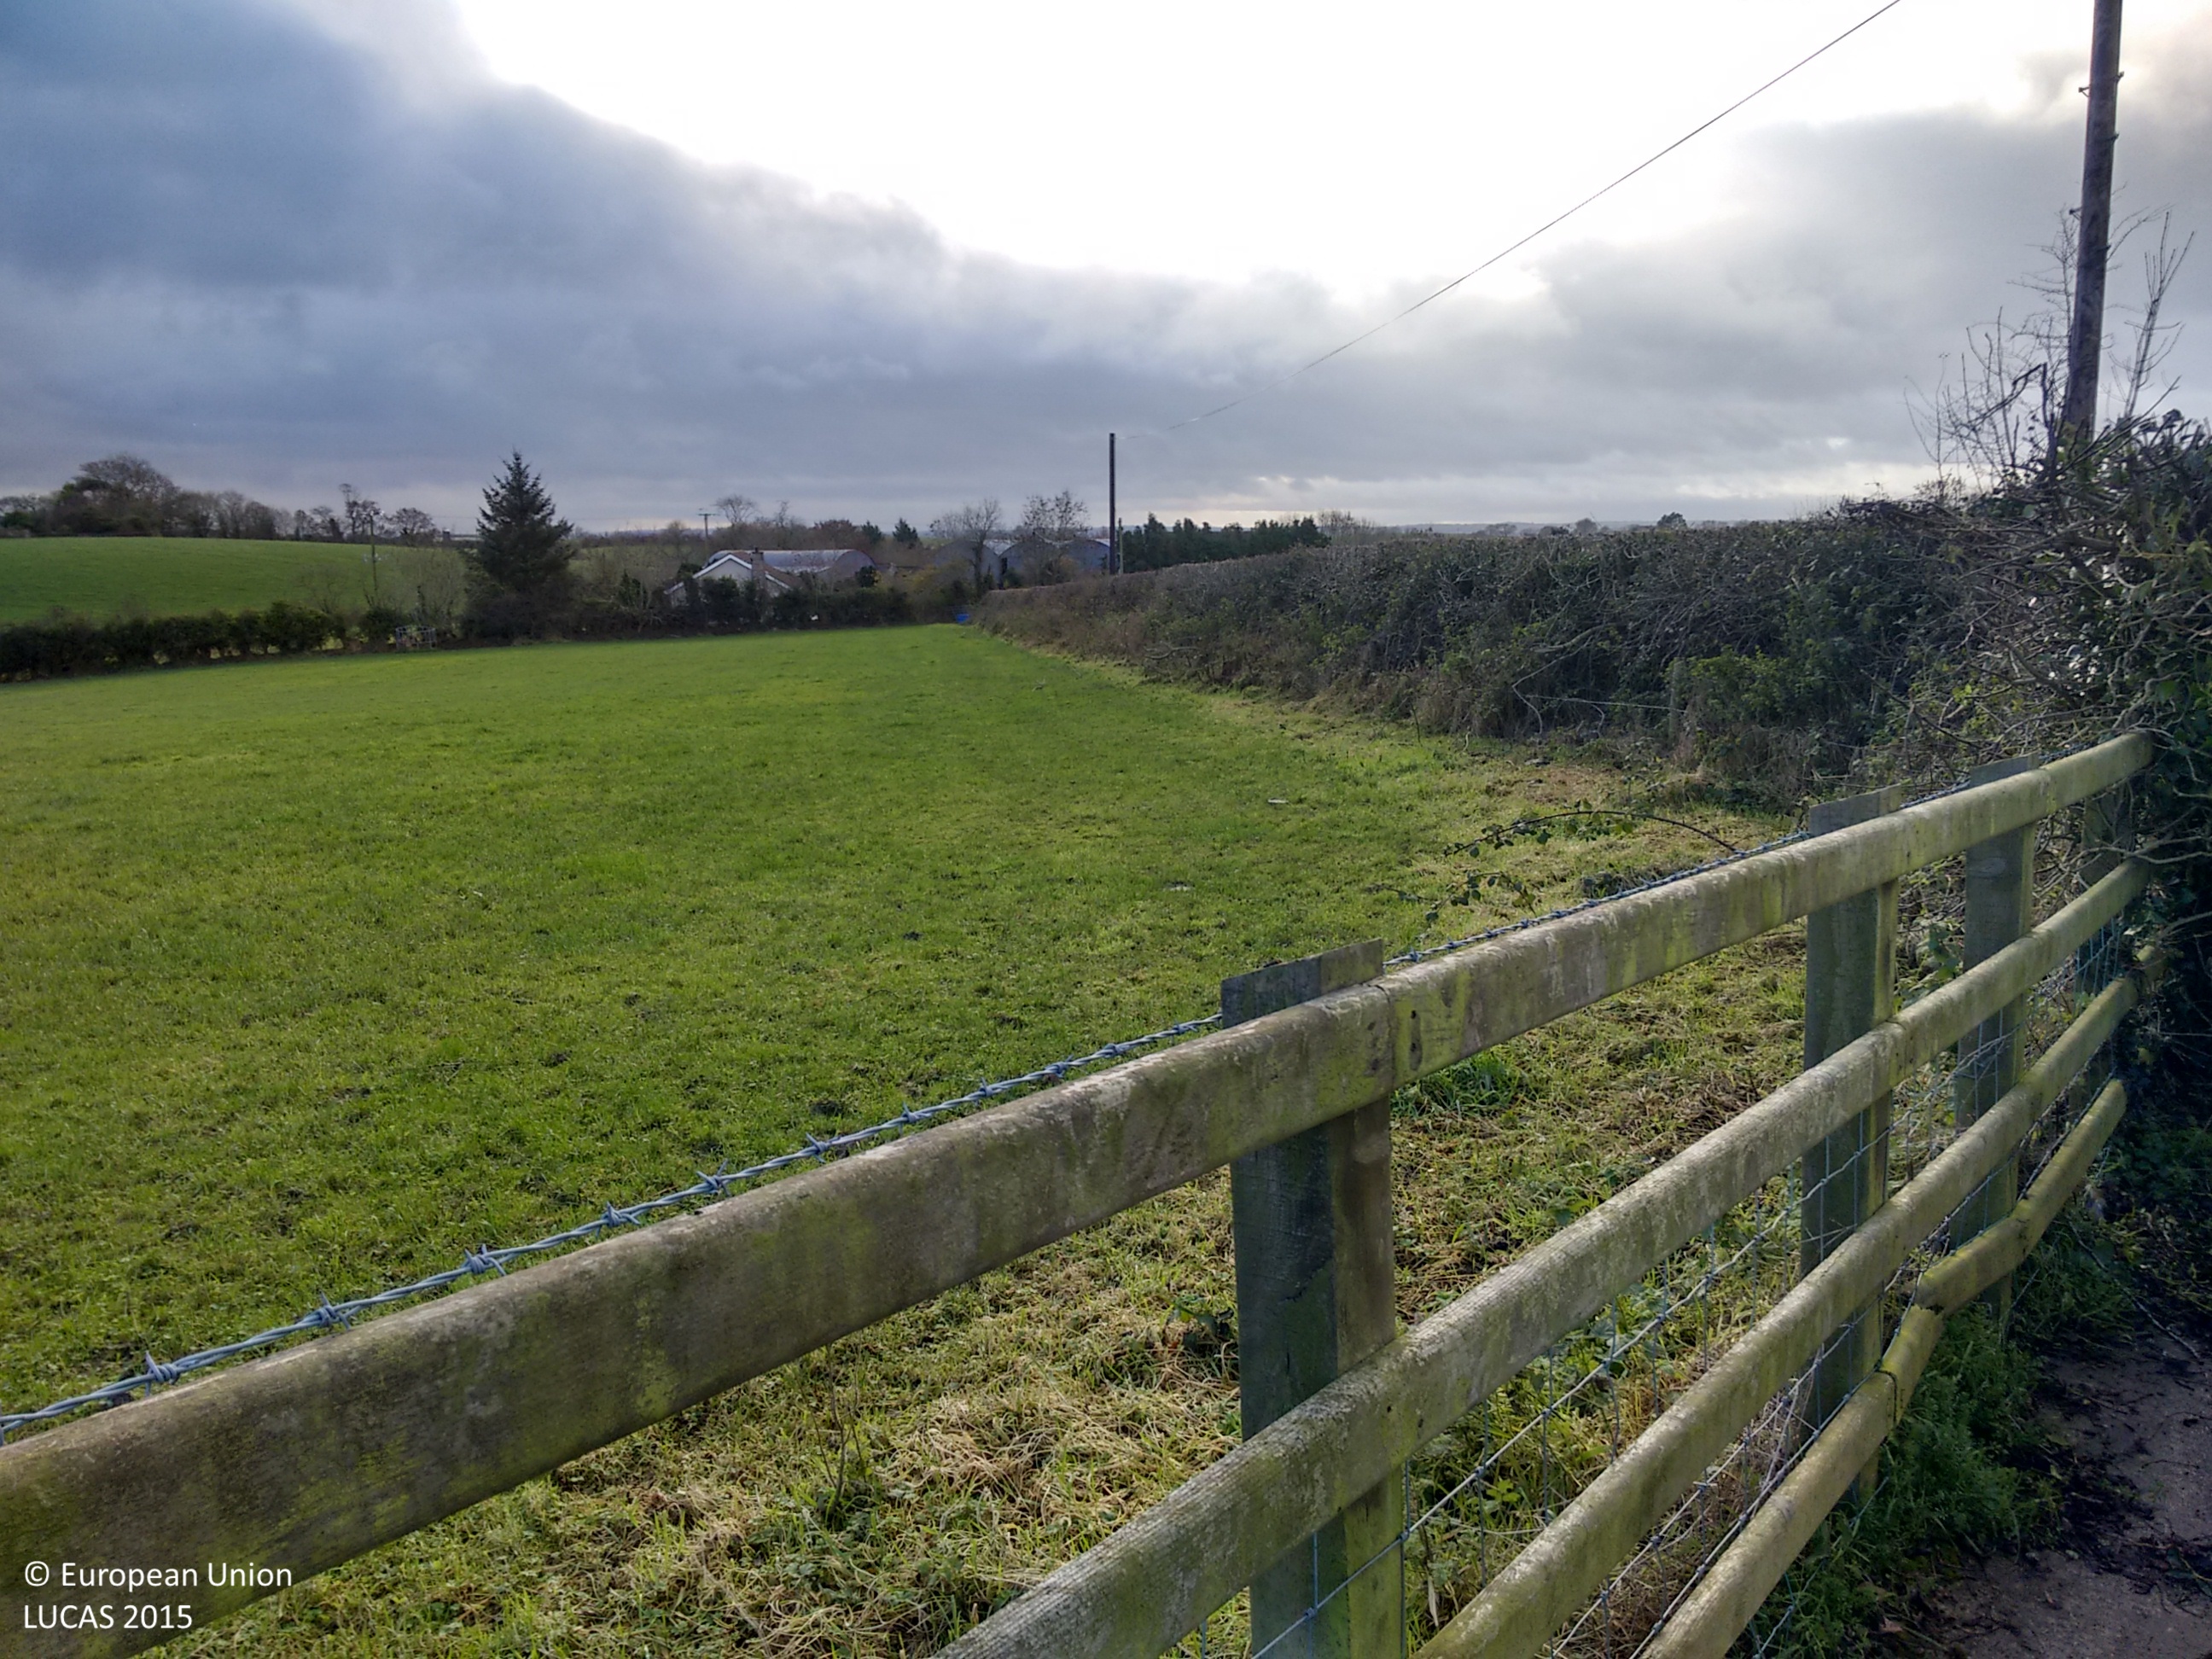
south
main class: Grassland
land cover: Grassland without tree/shrub cover
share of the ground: > 75 %
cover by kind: herbaceous plants 100 %
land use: Agriculture (excluding fallow land and kitchen gardens)
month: November
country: GB
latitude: 54.5940
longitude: -5.6546
